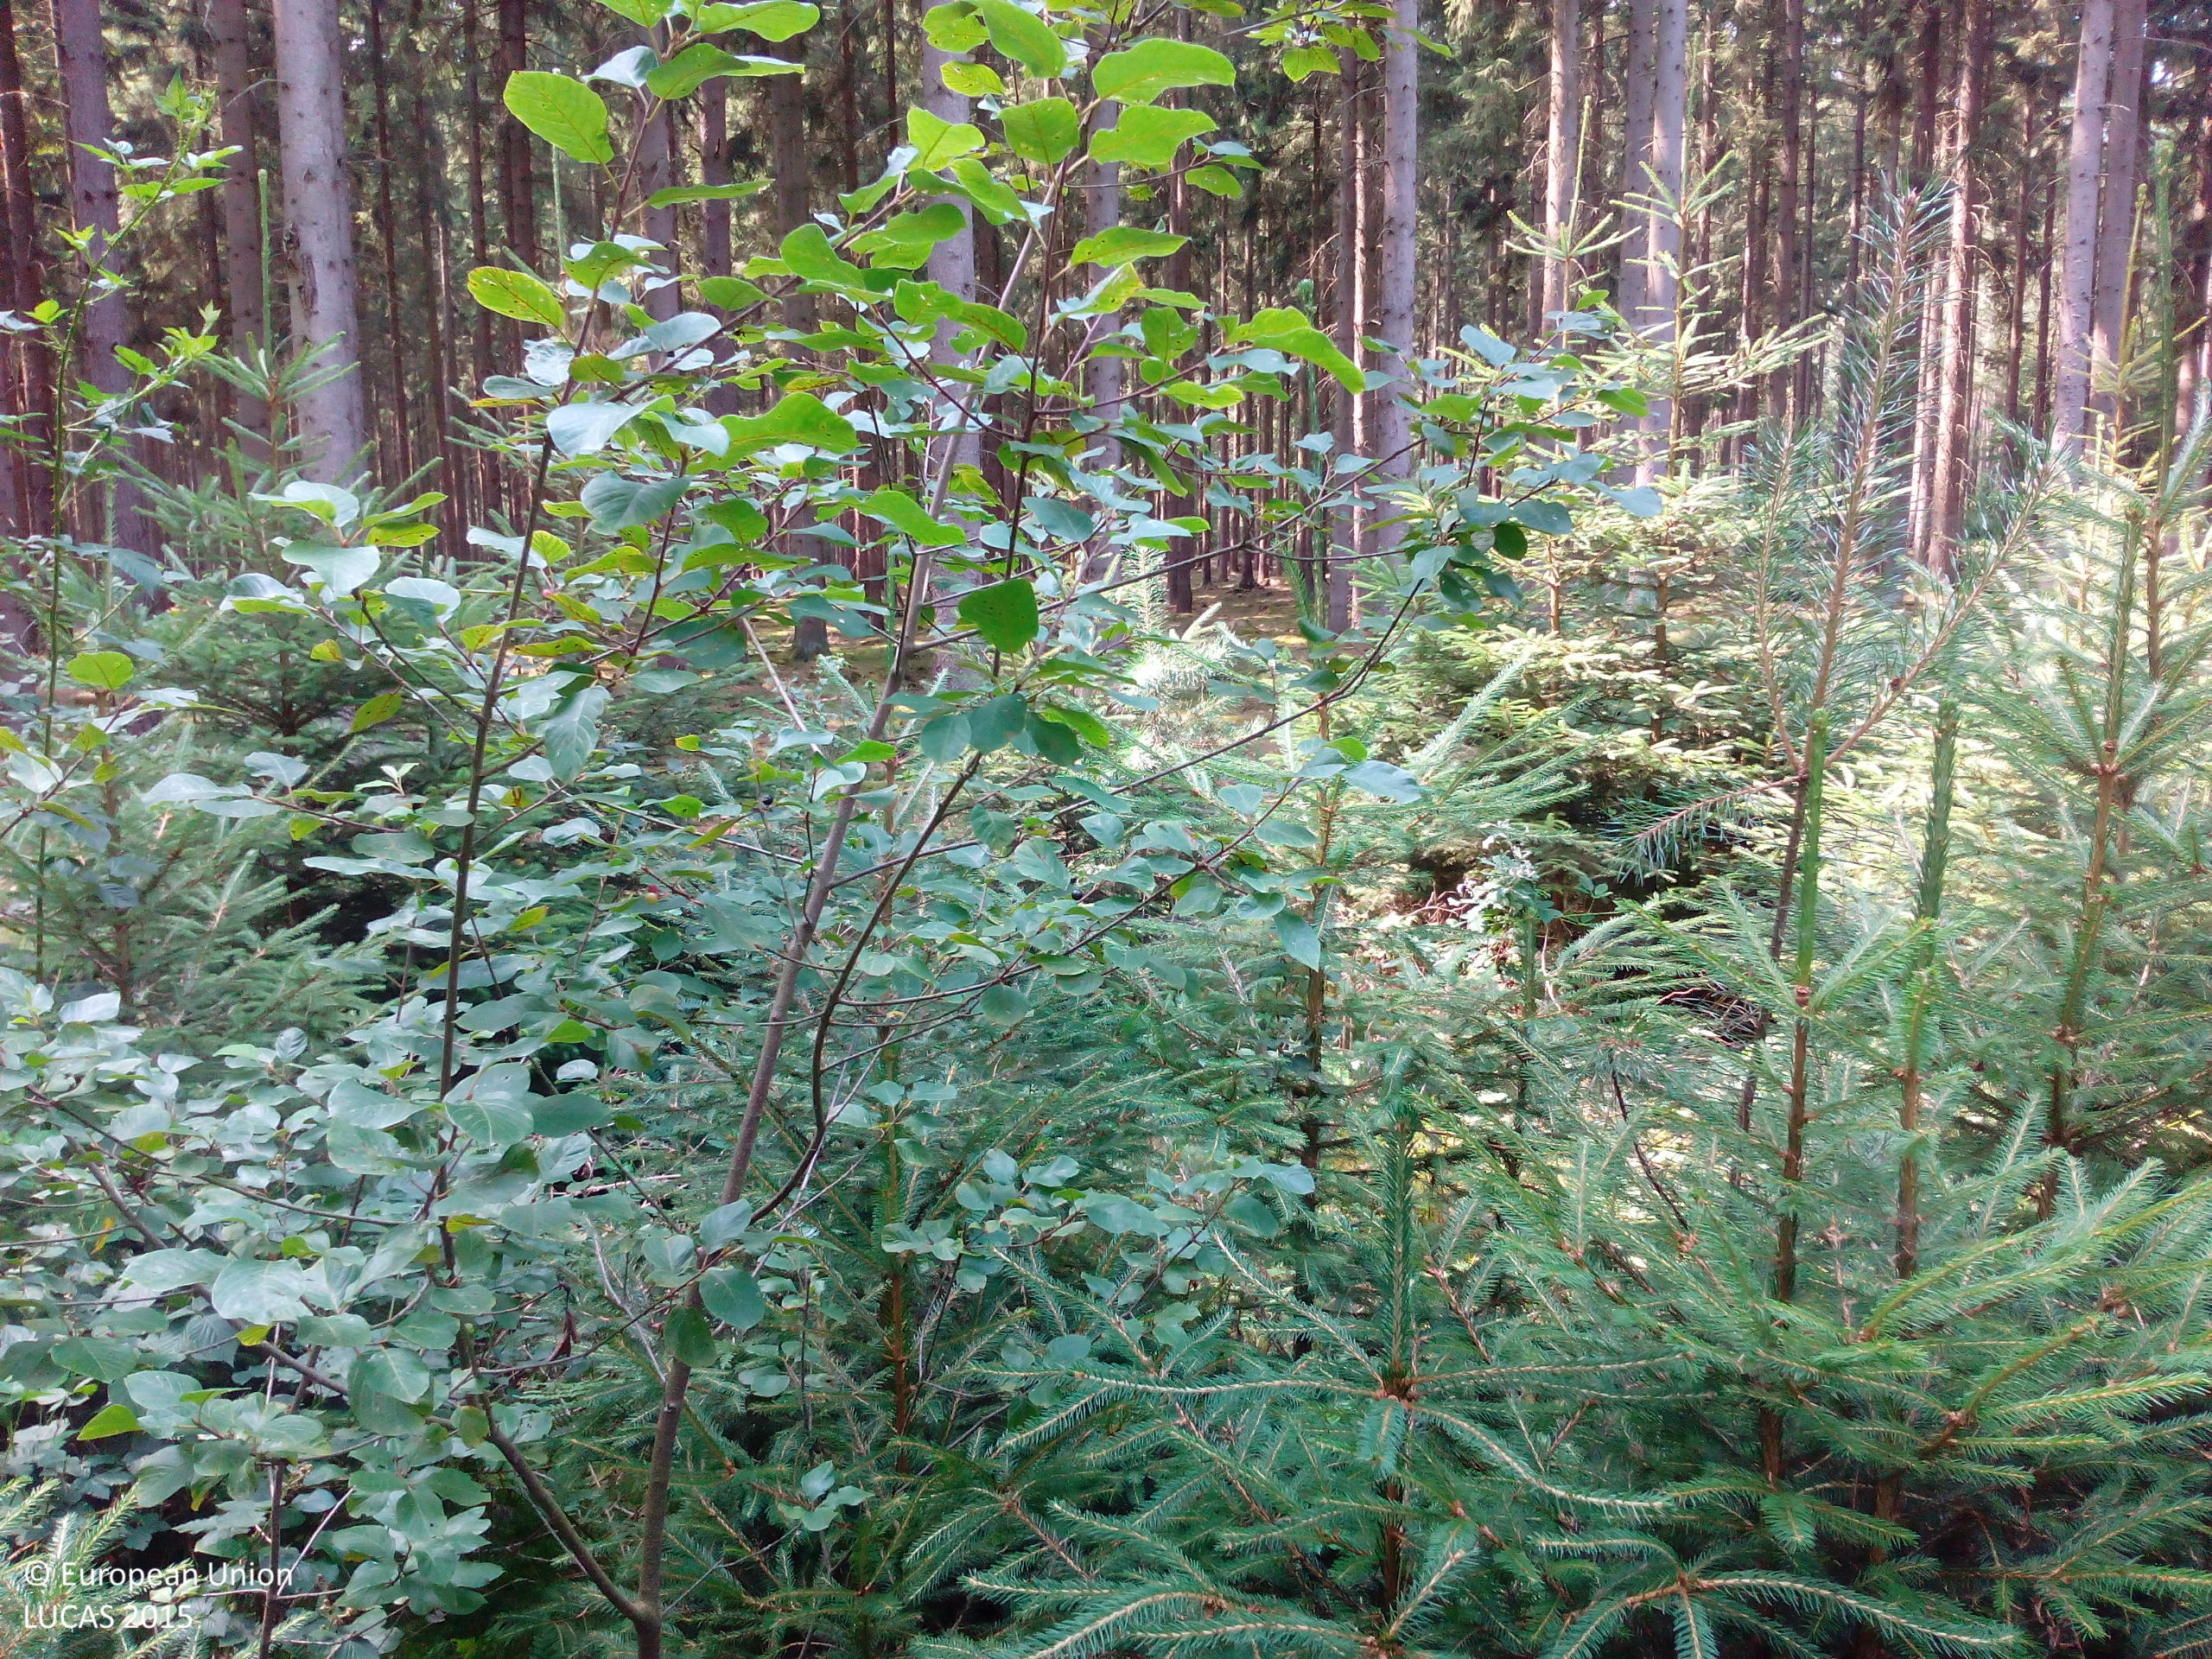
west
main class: Woodland
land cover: Spruce dominated coniferous woodland
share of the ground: 50 - 75 %
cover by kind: coniferous forest trees 70 %, herbaceous plants 25 %, lichens and mosses 5 %
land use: Forestry
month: August
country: DE
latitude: 53.0059
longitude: 10.3724
